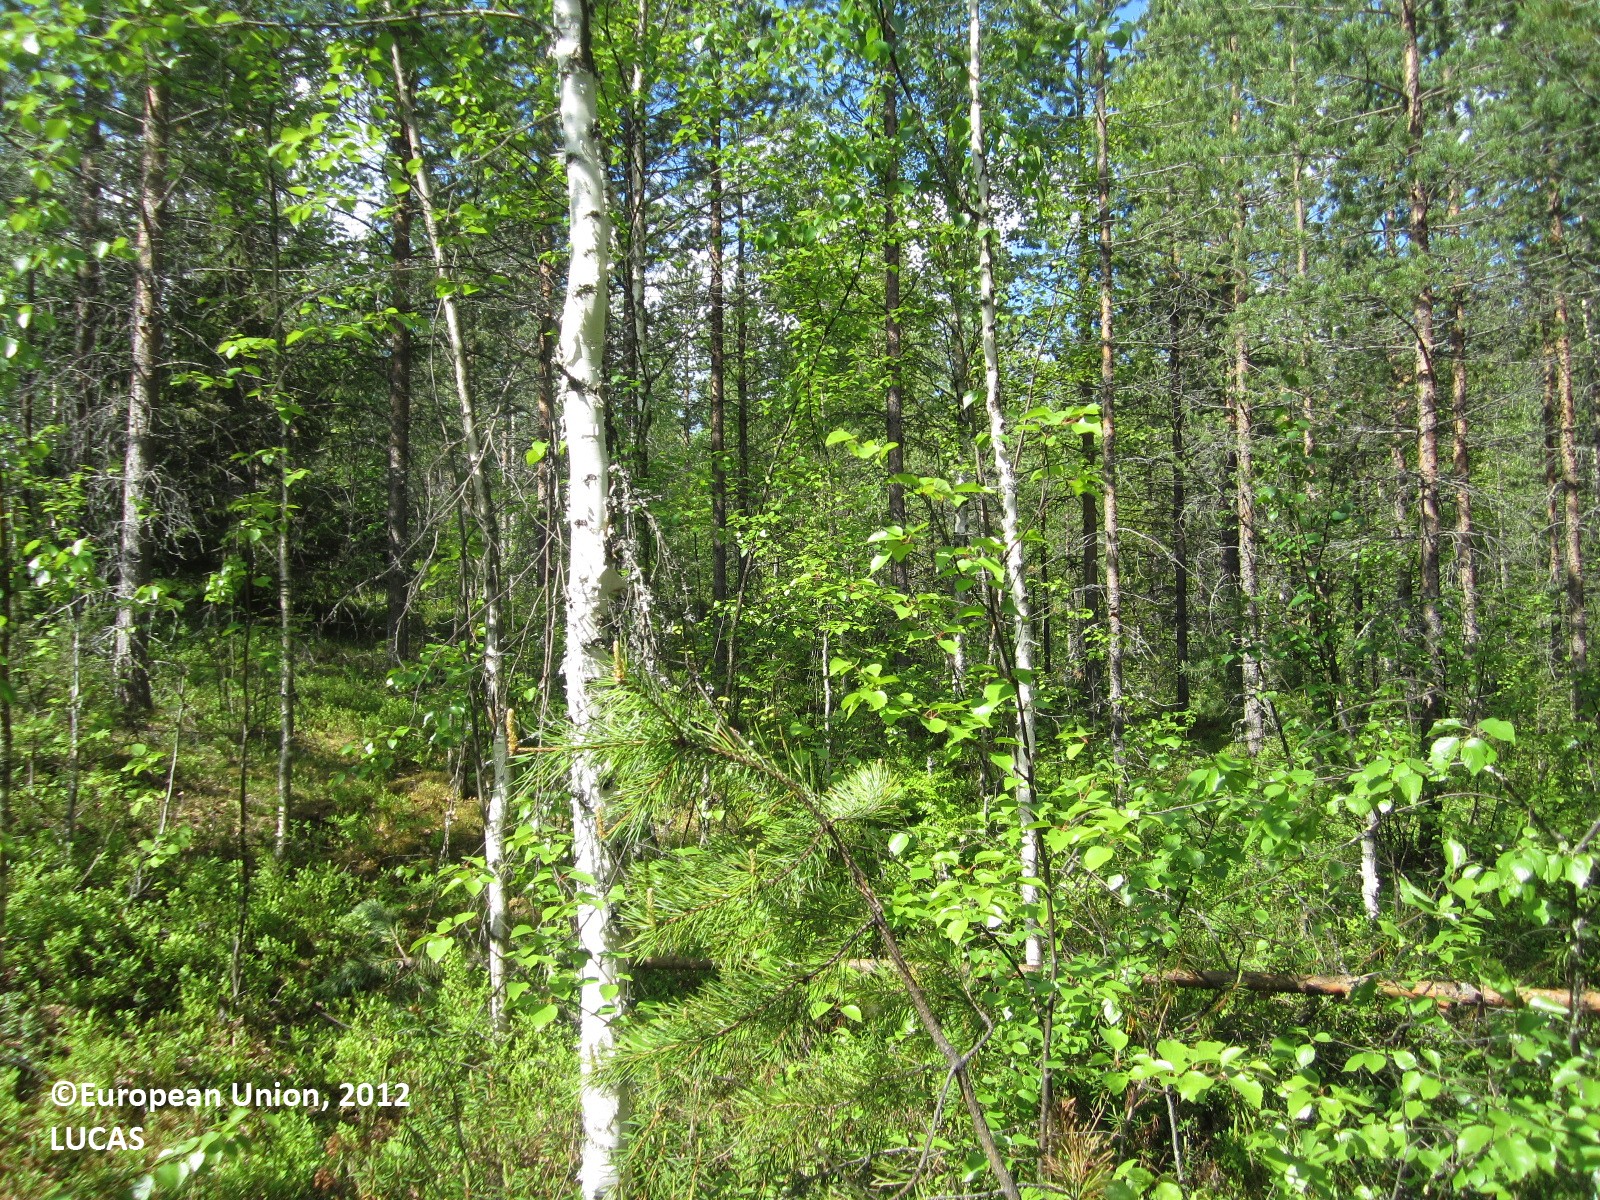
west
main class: Woodland
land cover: Pine dominated mixed woodland
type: boreal forest
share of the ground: 50 - 75 %
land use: Forestry
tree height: > 5 m
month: June
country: FI
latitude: 64.7977
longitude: 28.8975
